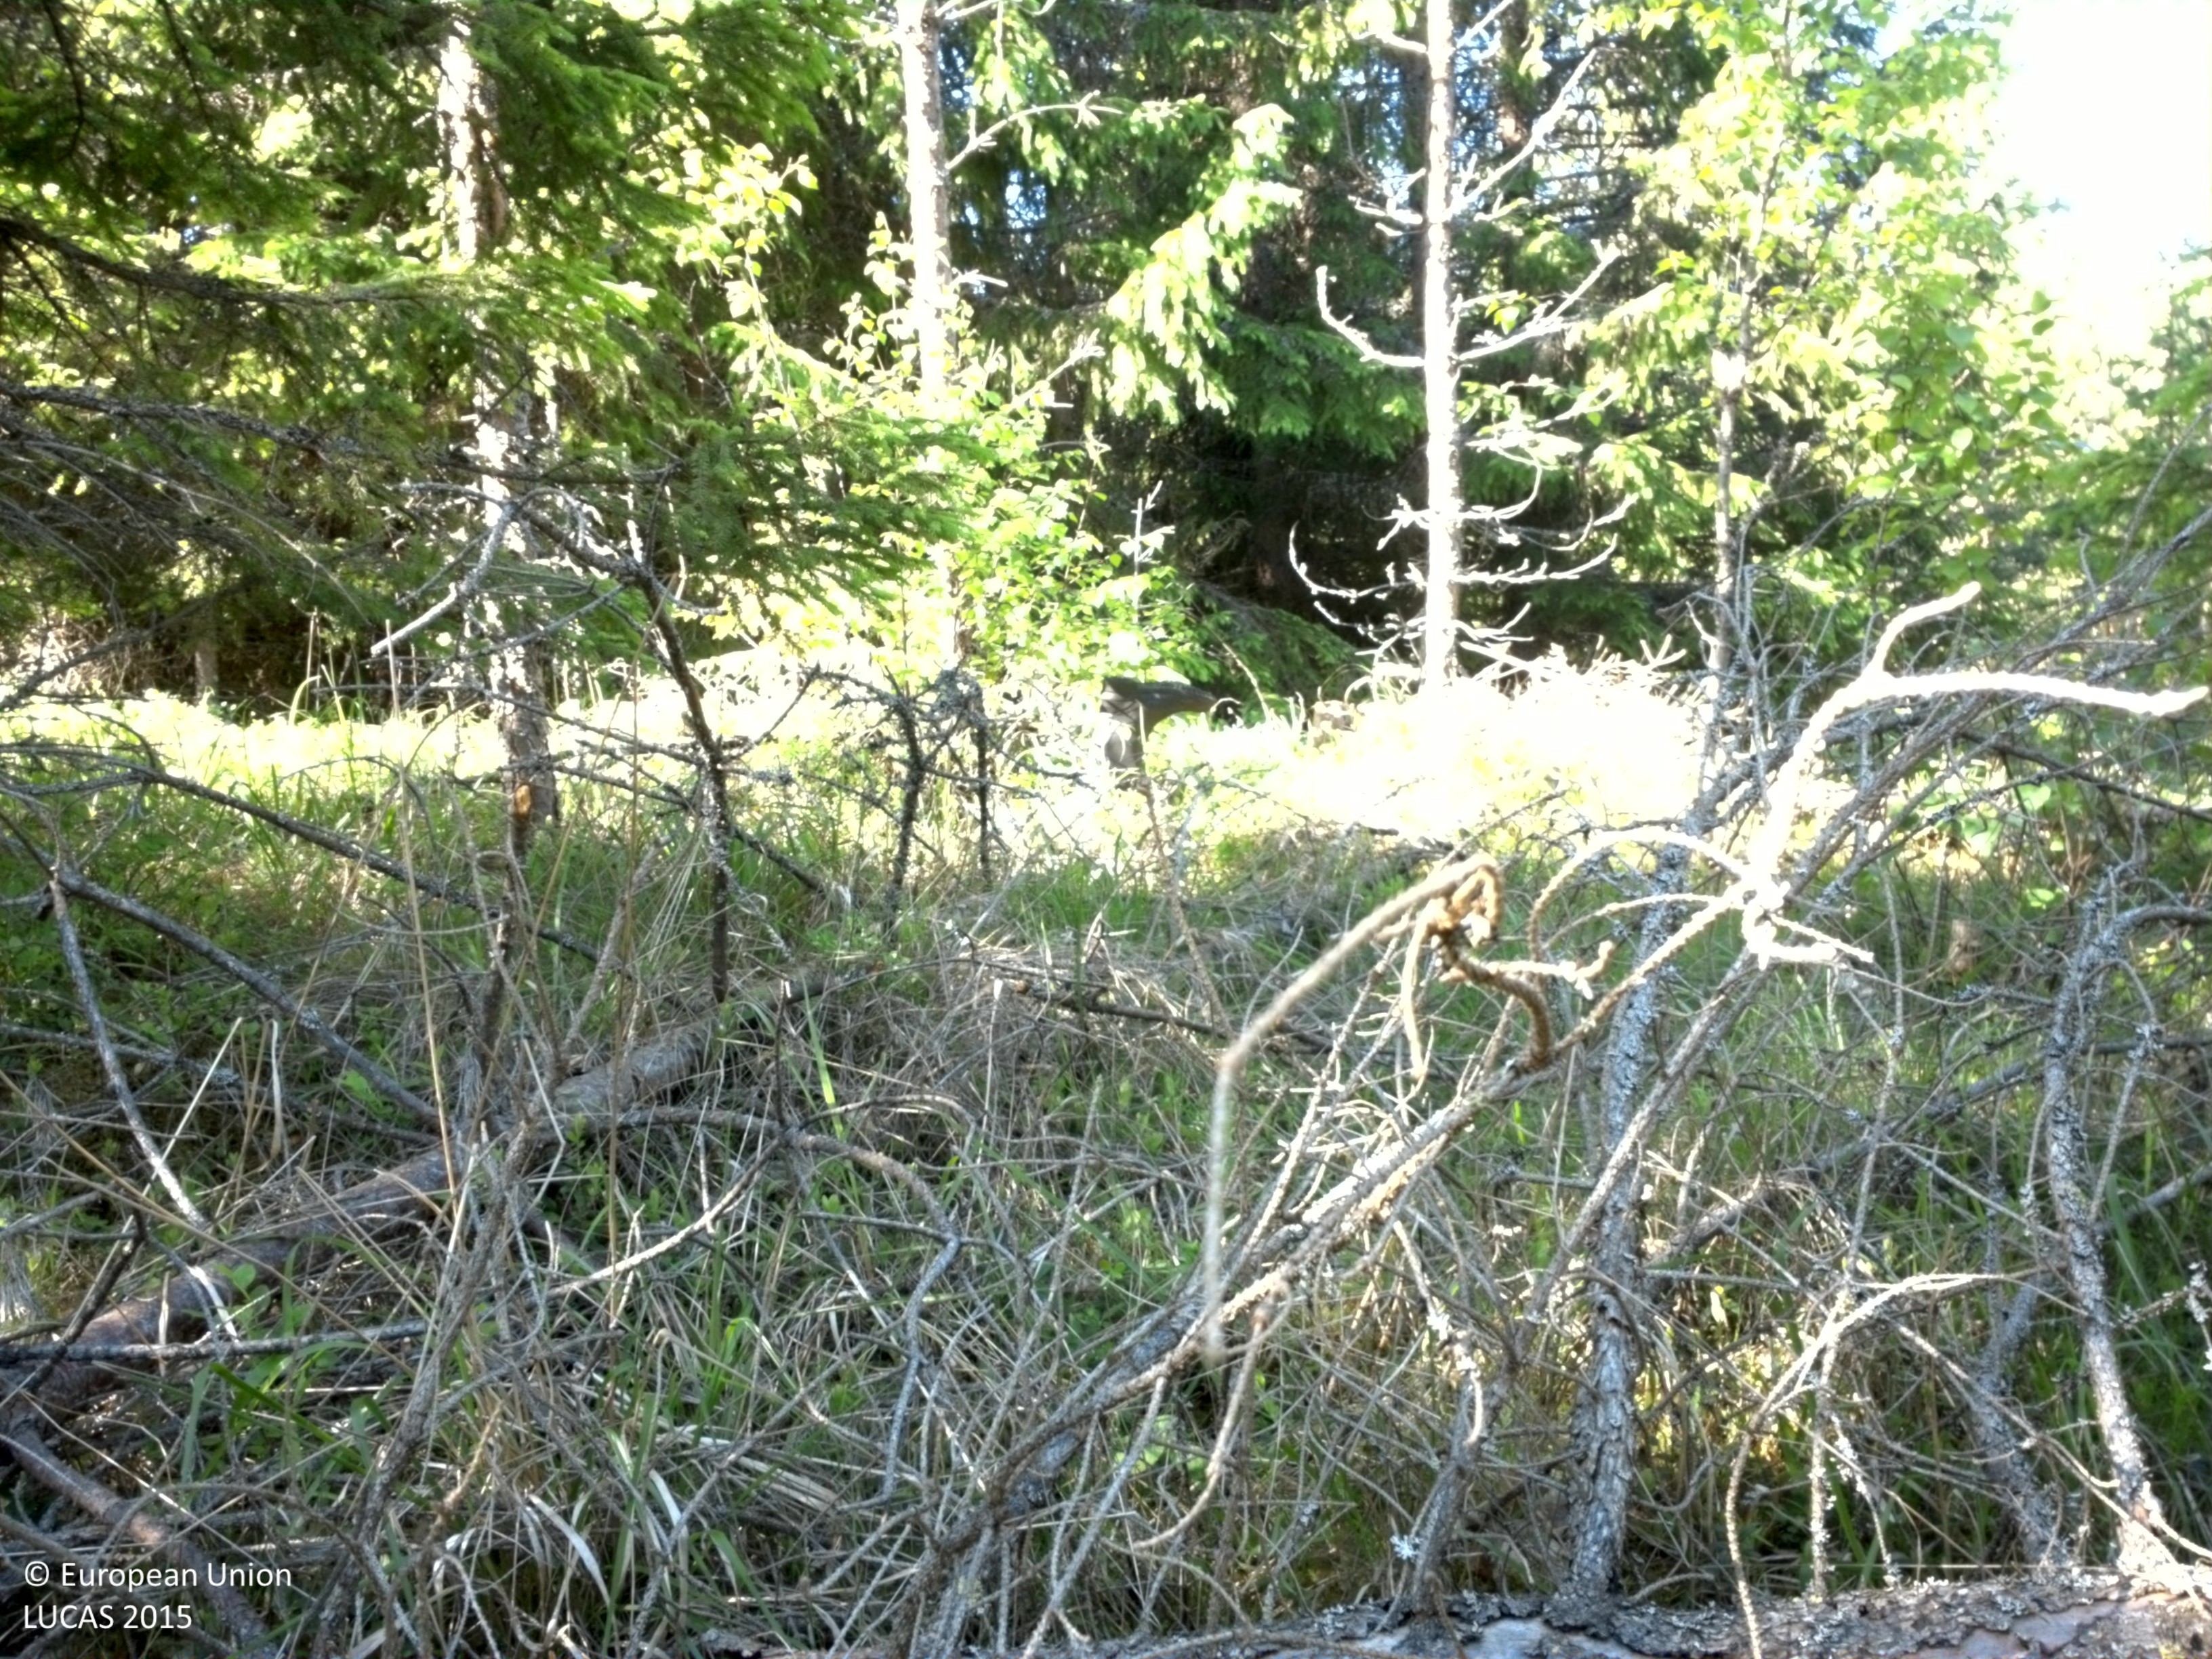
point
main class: Woodland
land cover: Other coniferous woodland
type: boreal forest
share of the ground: 50 - 75 %
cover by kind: coniferous forest trees 40 %, herbaceous plants 25 %, lichens and mosses 25 %, broadleaved forest trees 10 %
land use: Forestry
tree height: > 5 m
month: June
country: SE
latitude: 60.2142
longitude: 17.1920
